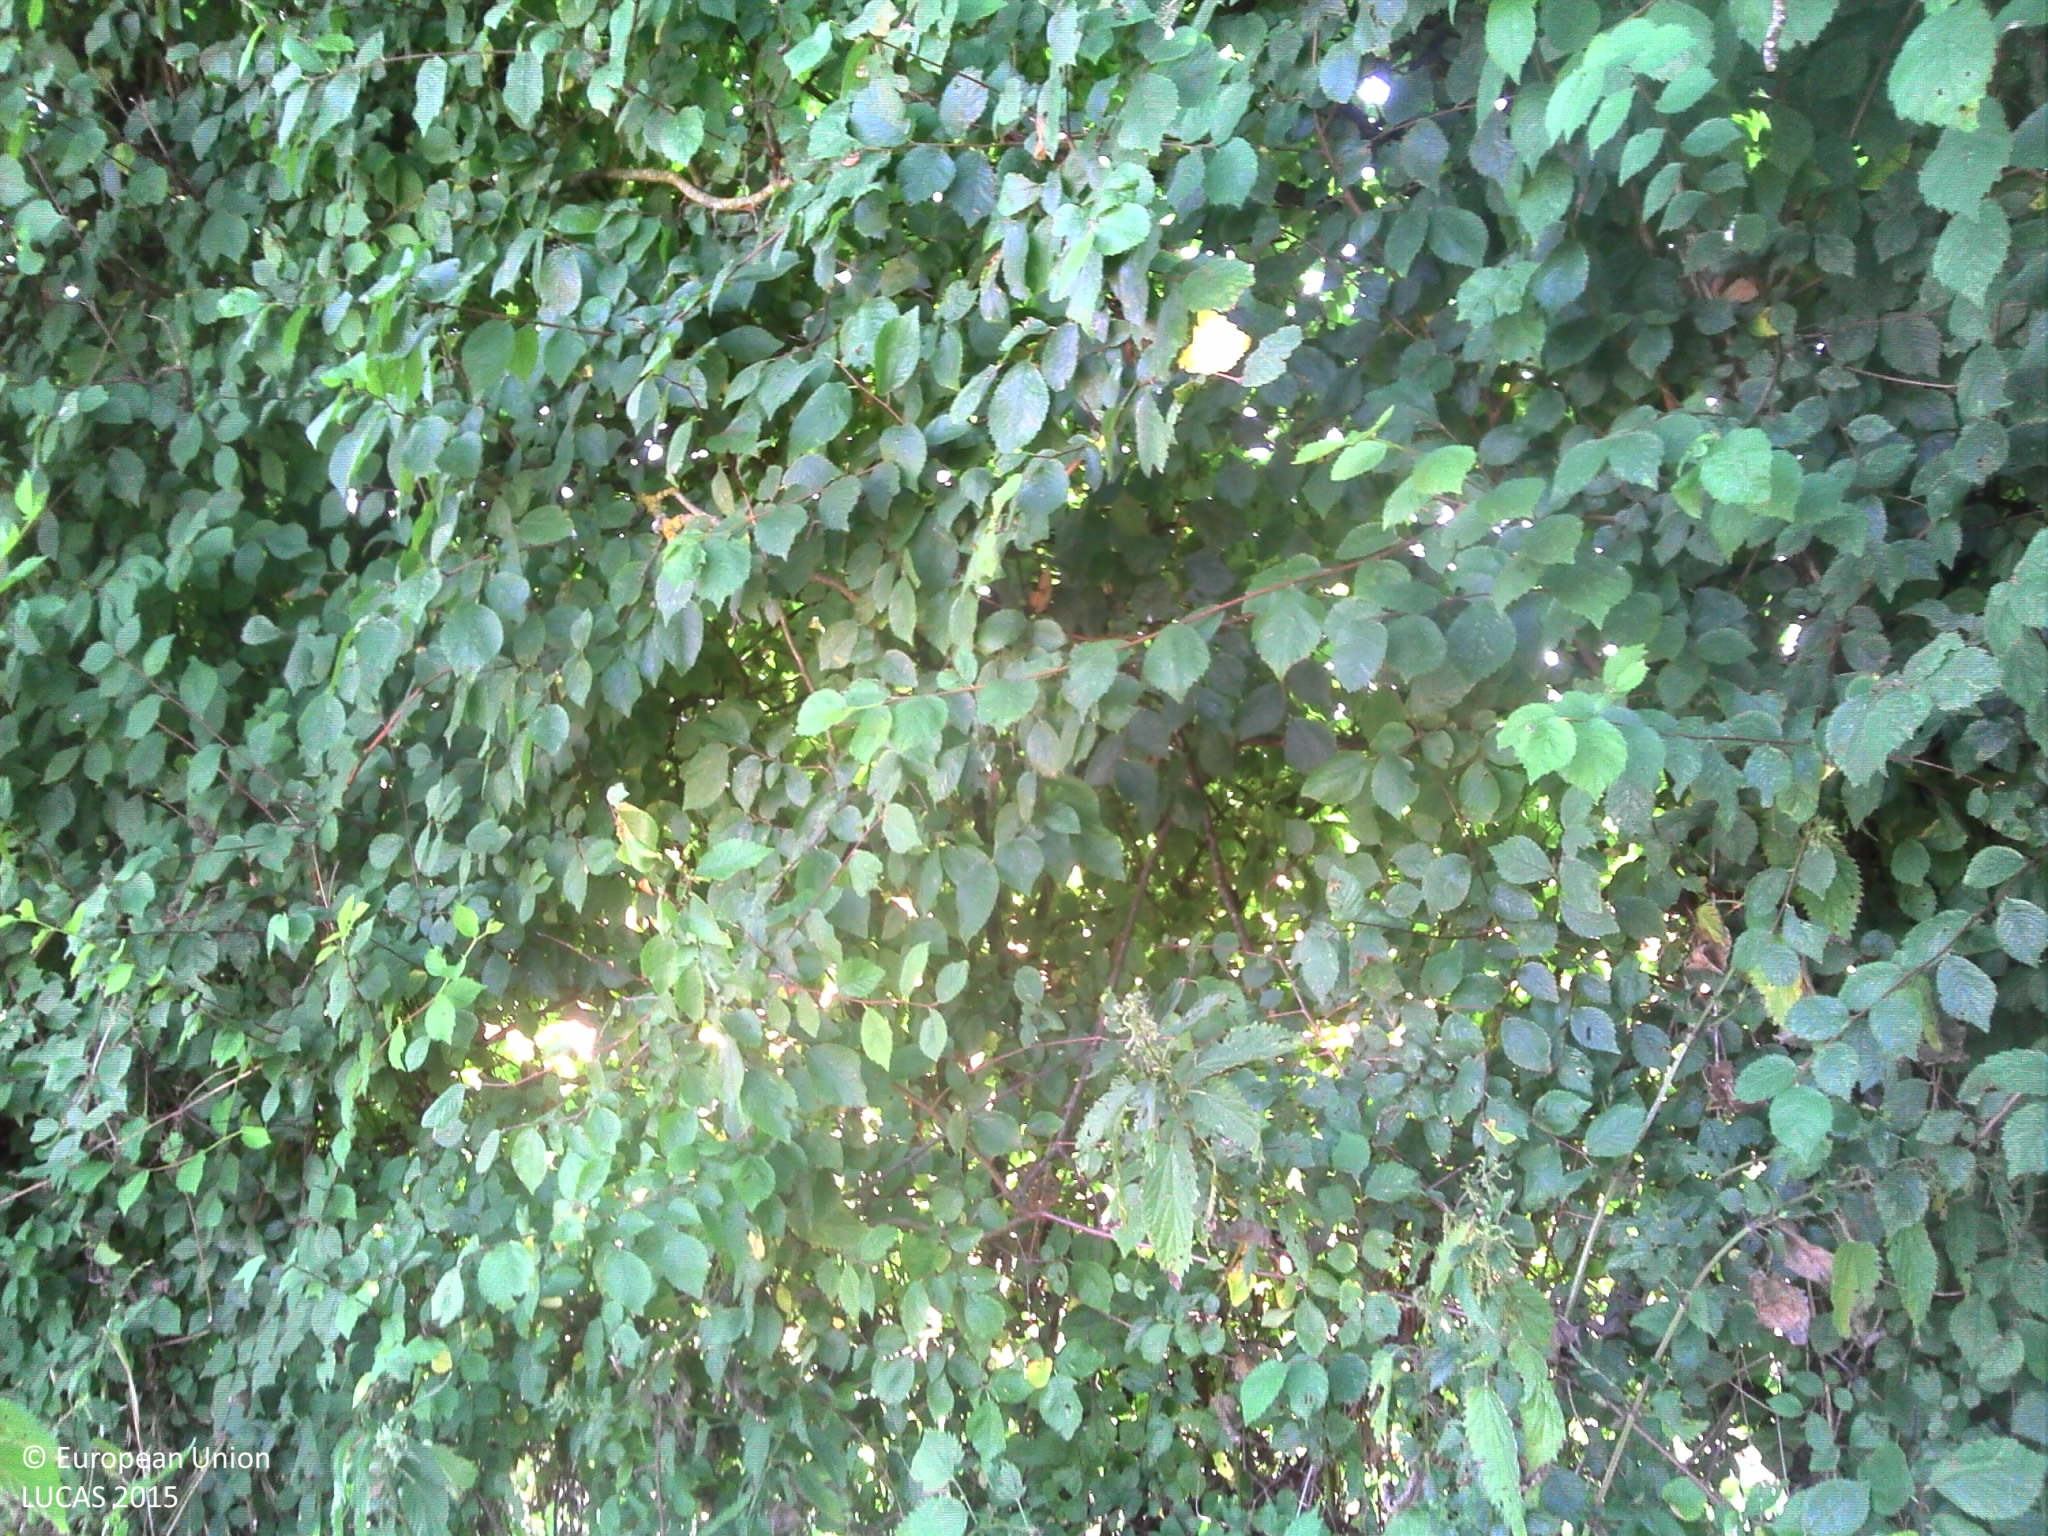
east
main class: Cropland
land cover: Common wheat
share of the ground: > 75 %
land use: Agriculture (excluding fallow land and kitchen gardens)
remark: Harvested field
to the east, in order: Common wheat; Abandoned hedges; Grass margins; Common wheat; Soya
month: July
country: FR
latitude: 45.7903
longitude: 5.1541
